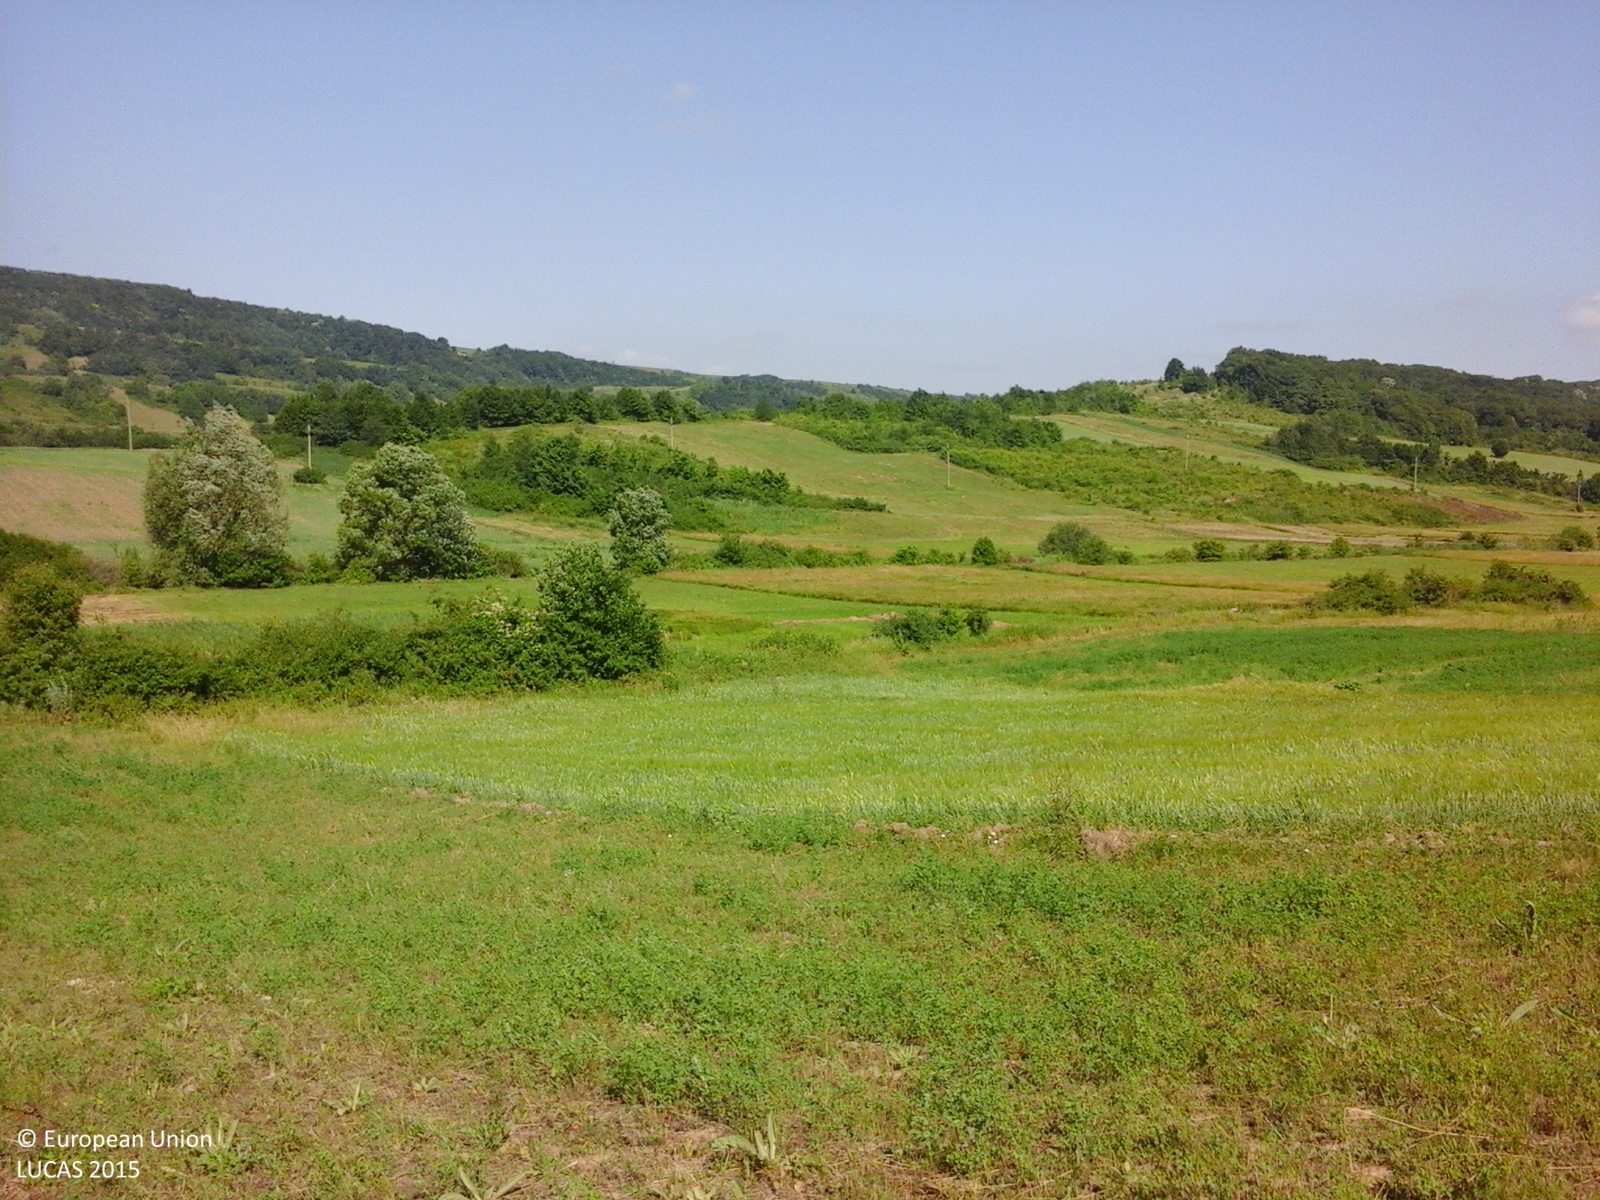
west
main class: Cropland
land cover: Other leguminous and mixtures for fodder
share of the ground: 10 - 25 %
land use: Agriculture (excluding fallow land and kitchen gardens)
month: June
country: RO
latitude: 46.5479
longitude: 27.6301
